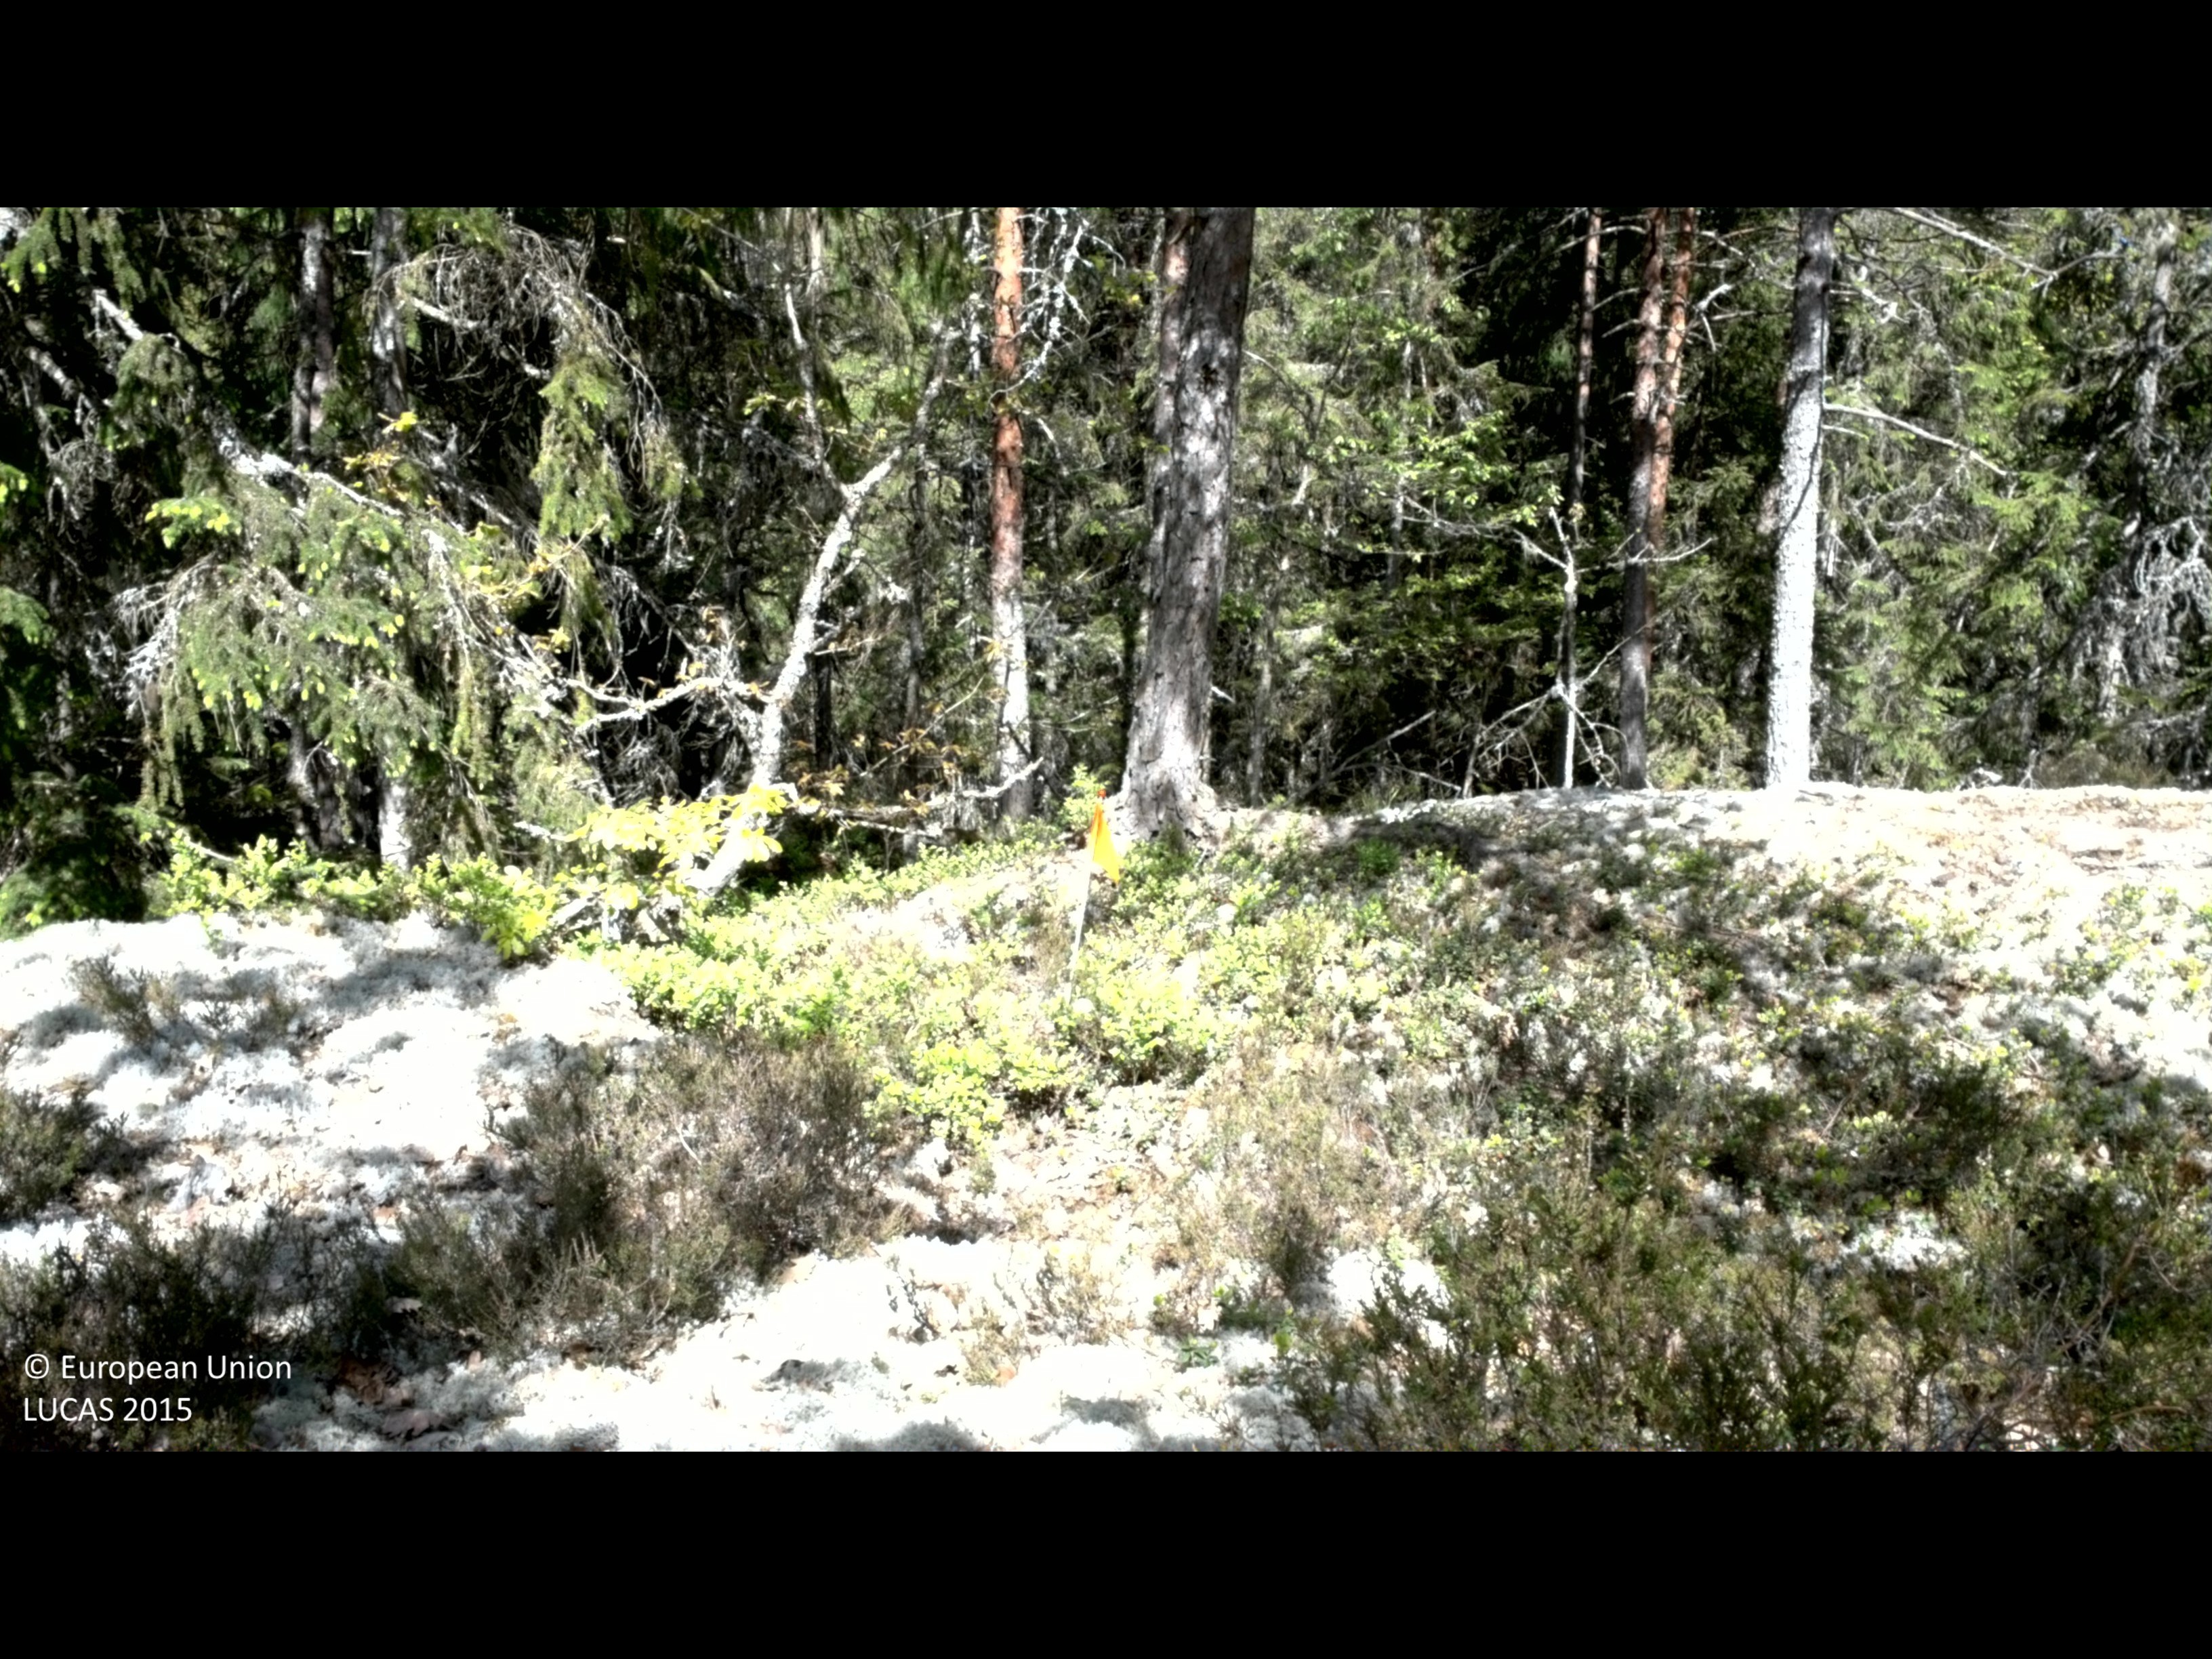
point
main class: Woodland
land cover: Pine dominated coniferous woodland
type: boreal forest
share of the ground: > 75 %
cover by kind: coniferous forest trees 80 %, shrubs 10 %, broadleaved forest trees 5 %, lichens and mosses 5 %
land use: Forestry
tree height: > 5 m
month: May
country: SE
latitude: 57.3026
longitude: 16.1565
